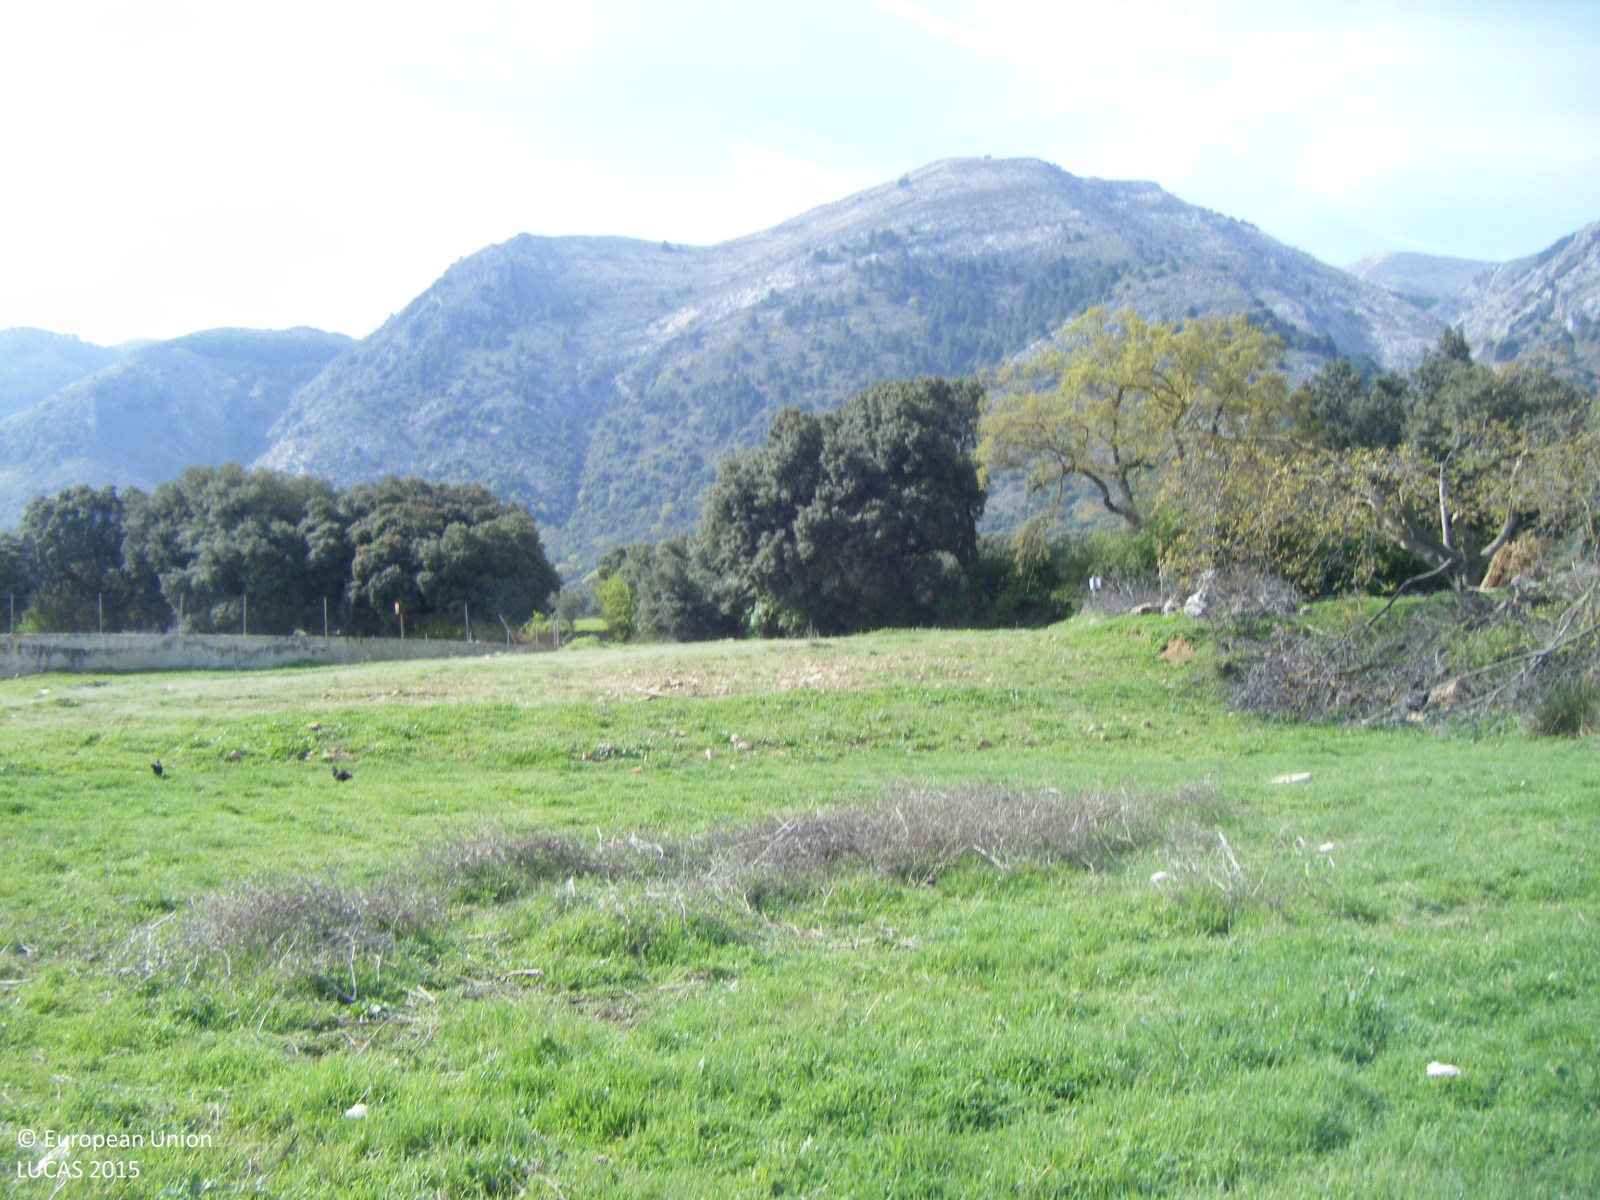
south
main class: Grassland
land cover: Spontaneously vegetated surfaces
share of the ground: > 75 %
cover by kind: herbaceous plants 100 %
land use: Agriculture (excluding fallow land and kitchen gardens)
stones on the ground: < 10 %
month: April
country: ES
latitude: 36.9398
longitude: -4.0360
